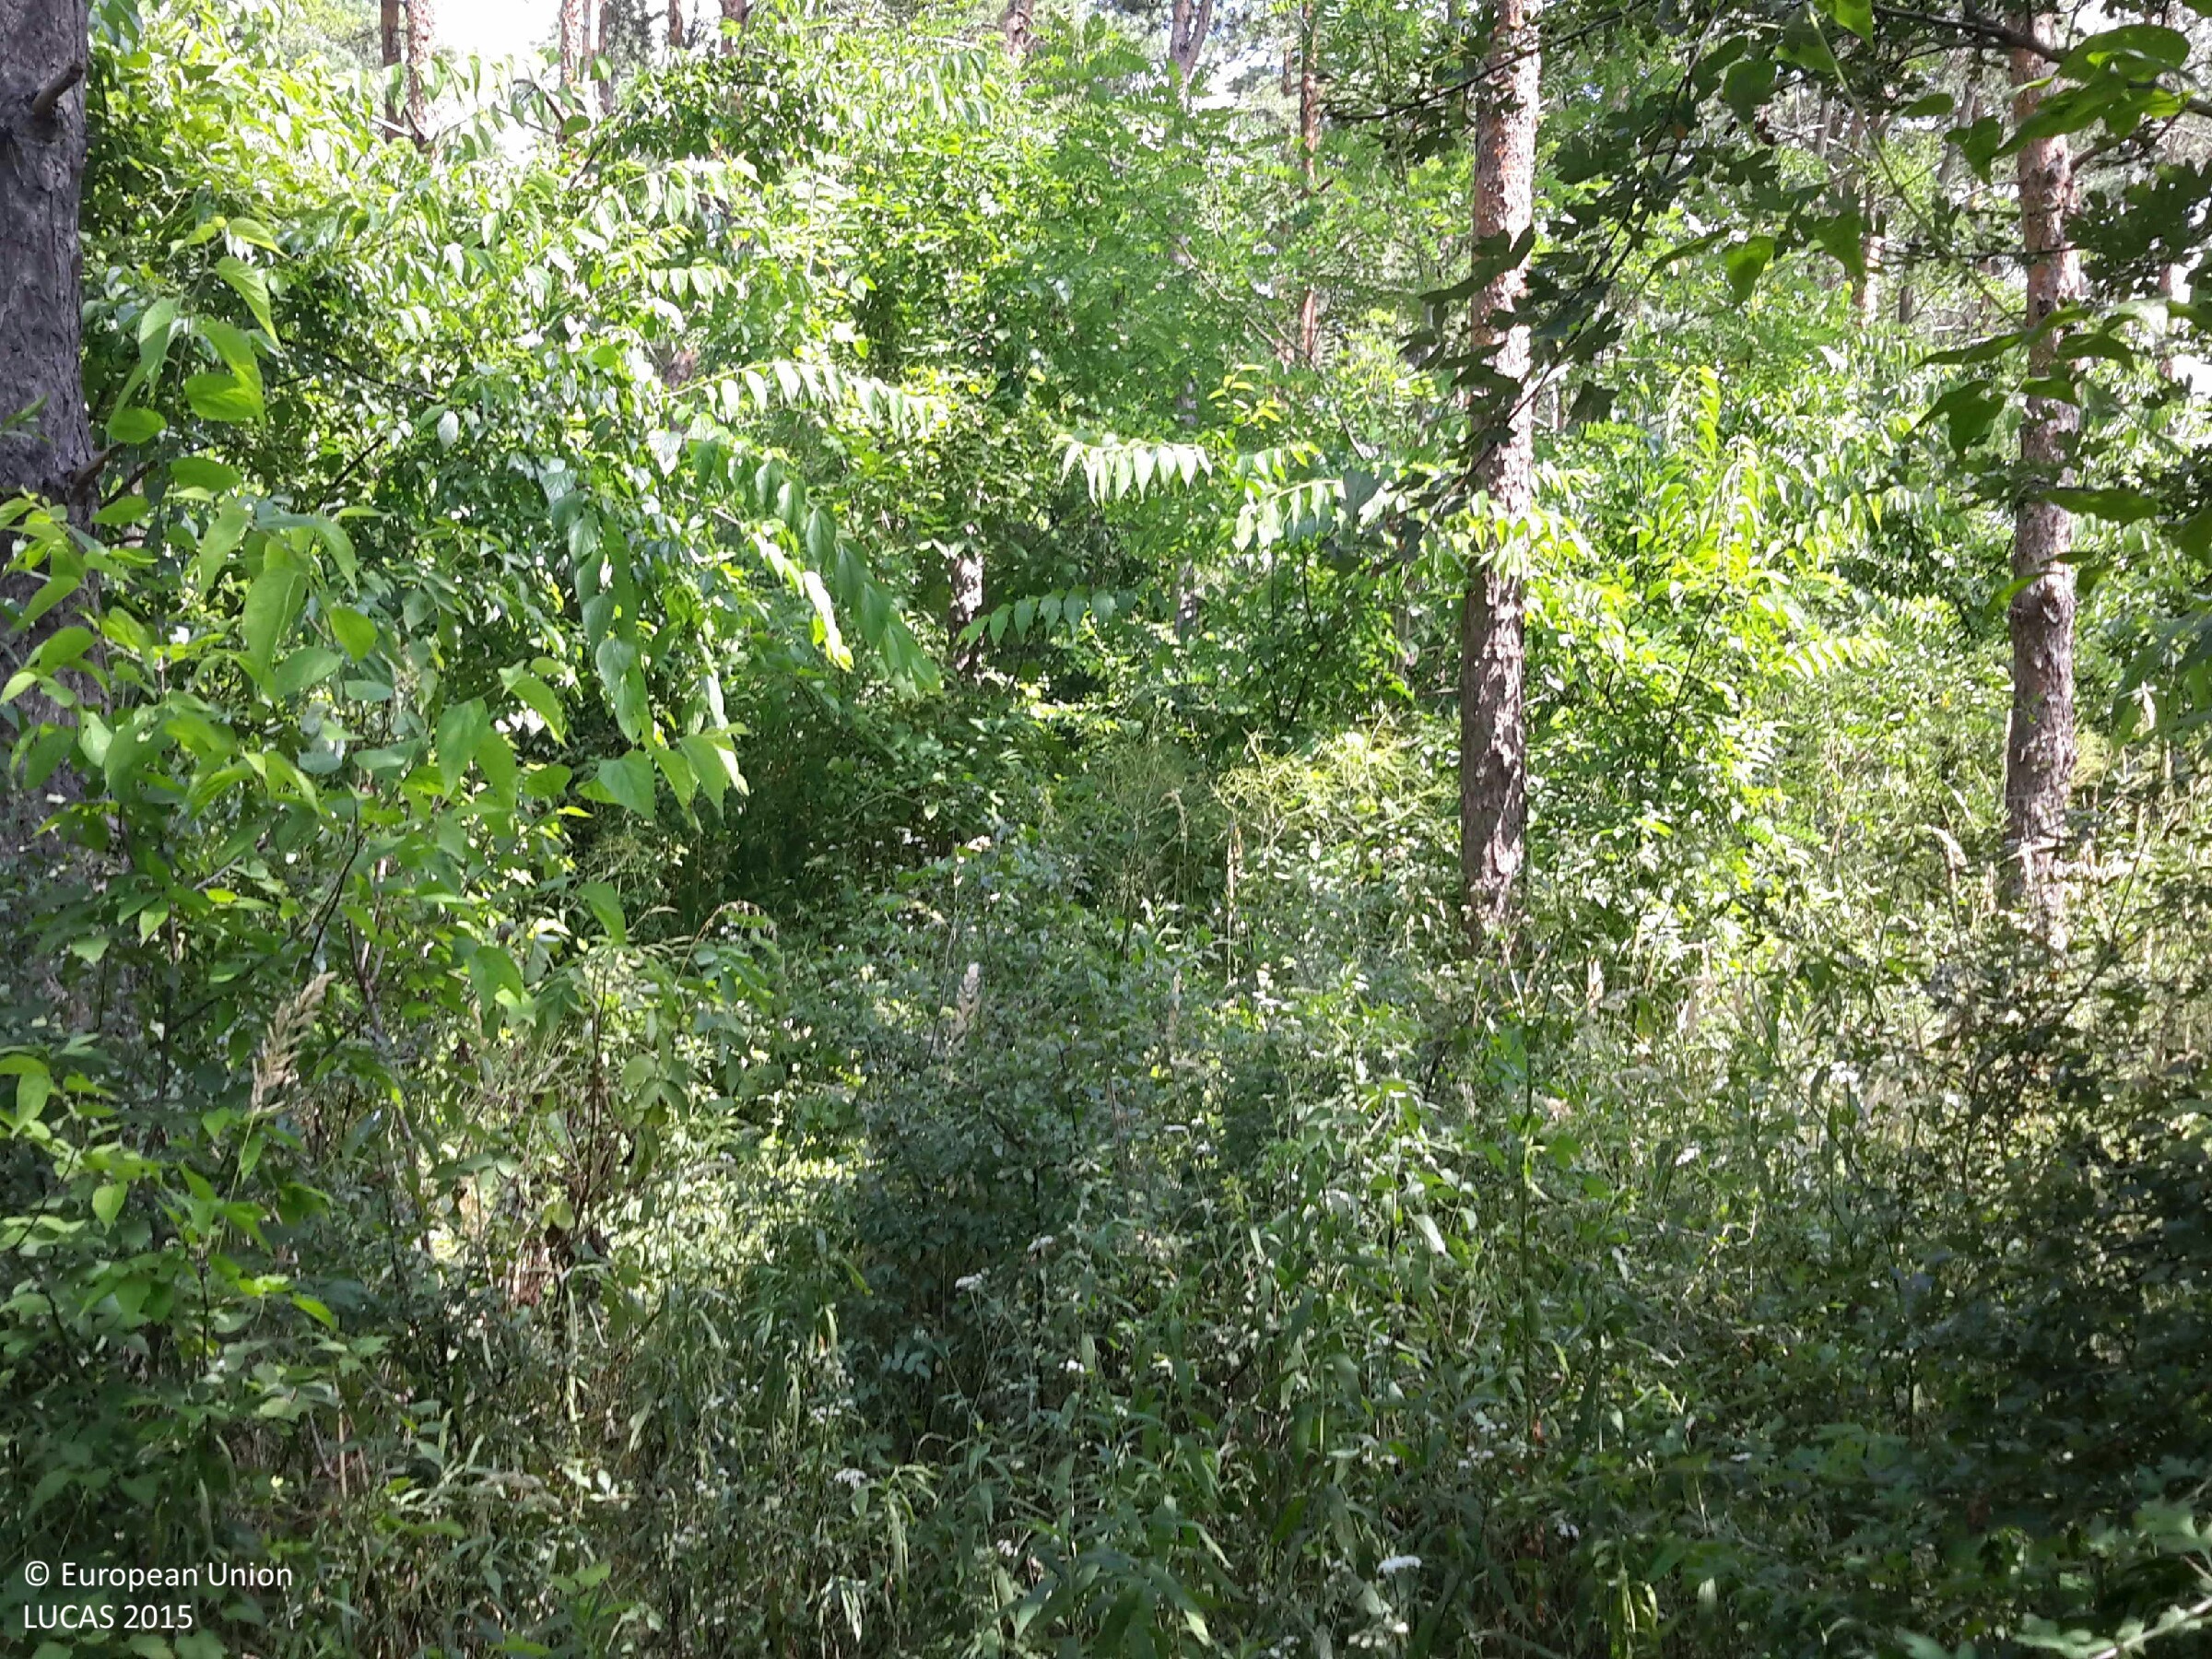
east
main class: Woodland
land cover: Broadleaved woodland
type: mesophytic deciduous forest
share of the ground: 50 - 75 %
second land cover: Spontaneously vegetated surfaces
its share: 25 - 50 %
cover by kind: broadleaved forest trees 70 %, shrubs 20 %, herbaceous plants 10 %
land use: Forestry
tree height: > 5 m
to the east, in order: Broadleaved woodland; Spontaneously vegetated surfaces; Ditches and canals; Grass margins; Electric lines; Grass margins; Fences; Maize; Fences; Grass margins; Tracks; Grassland without tree/shrub cover
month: July
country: HU
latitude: 47.7235
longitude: 17.8899
